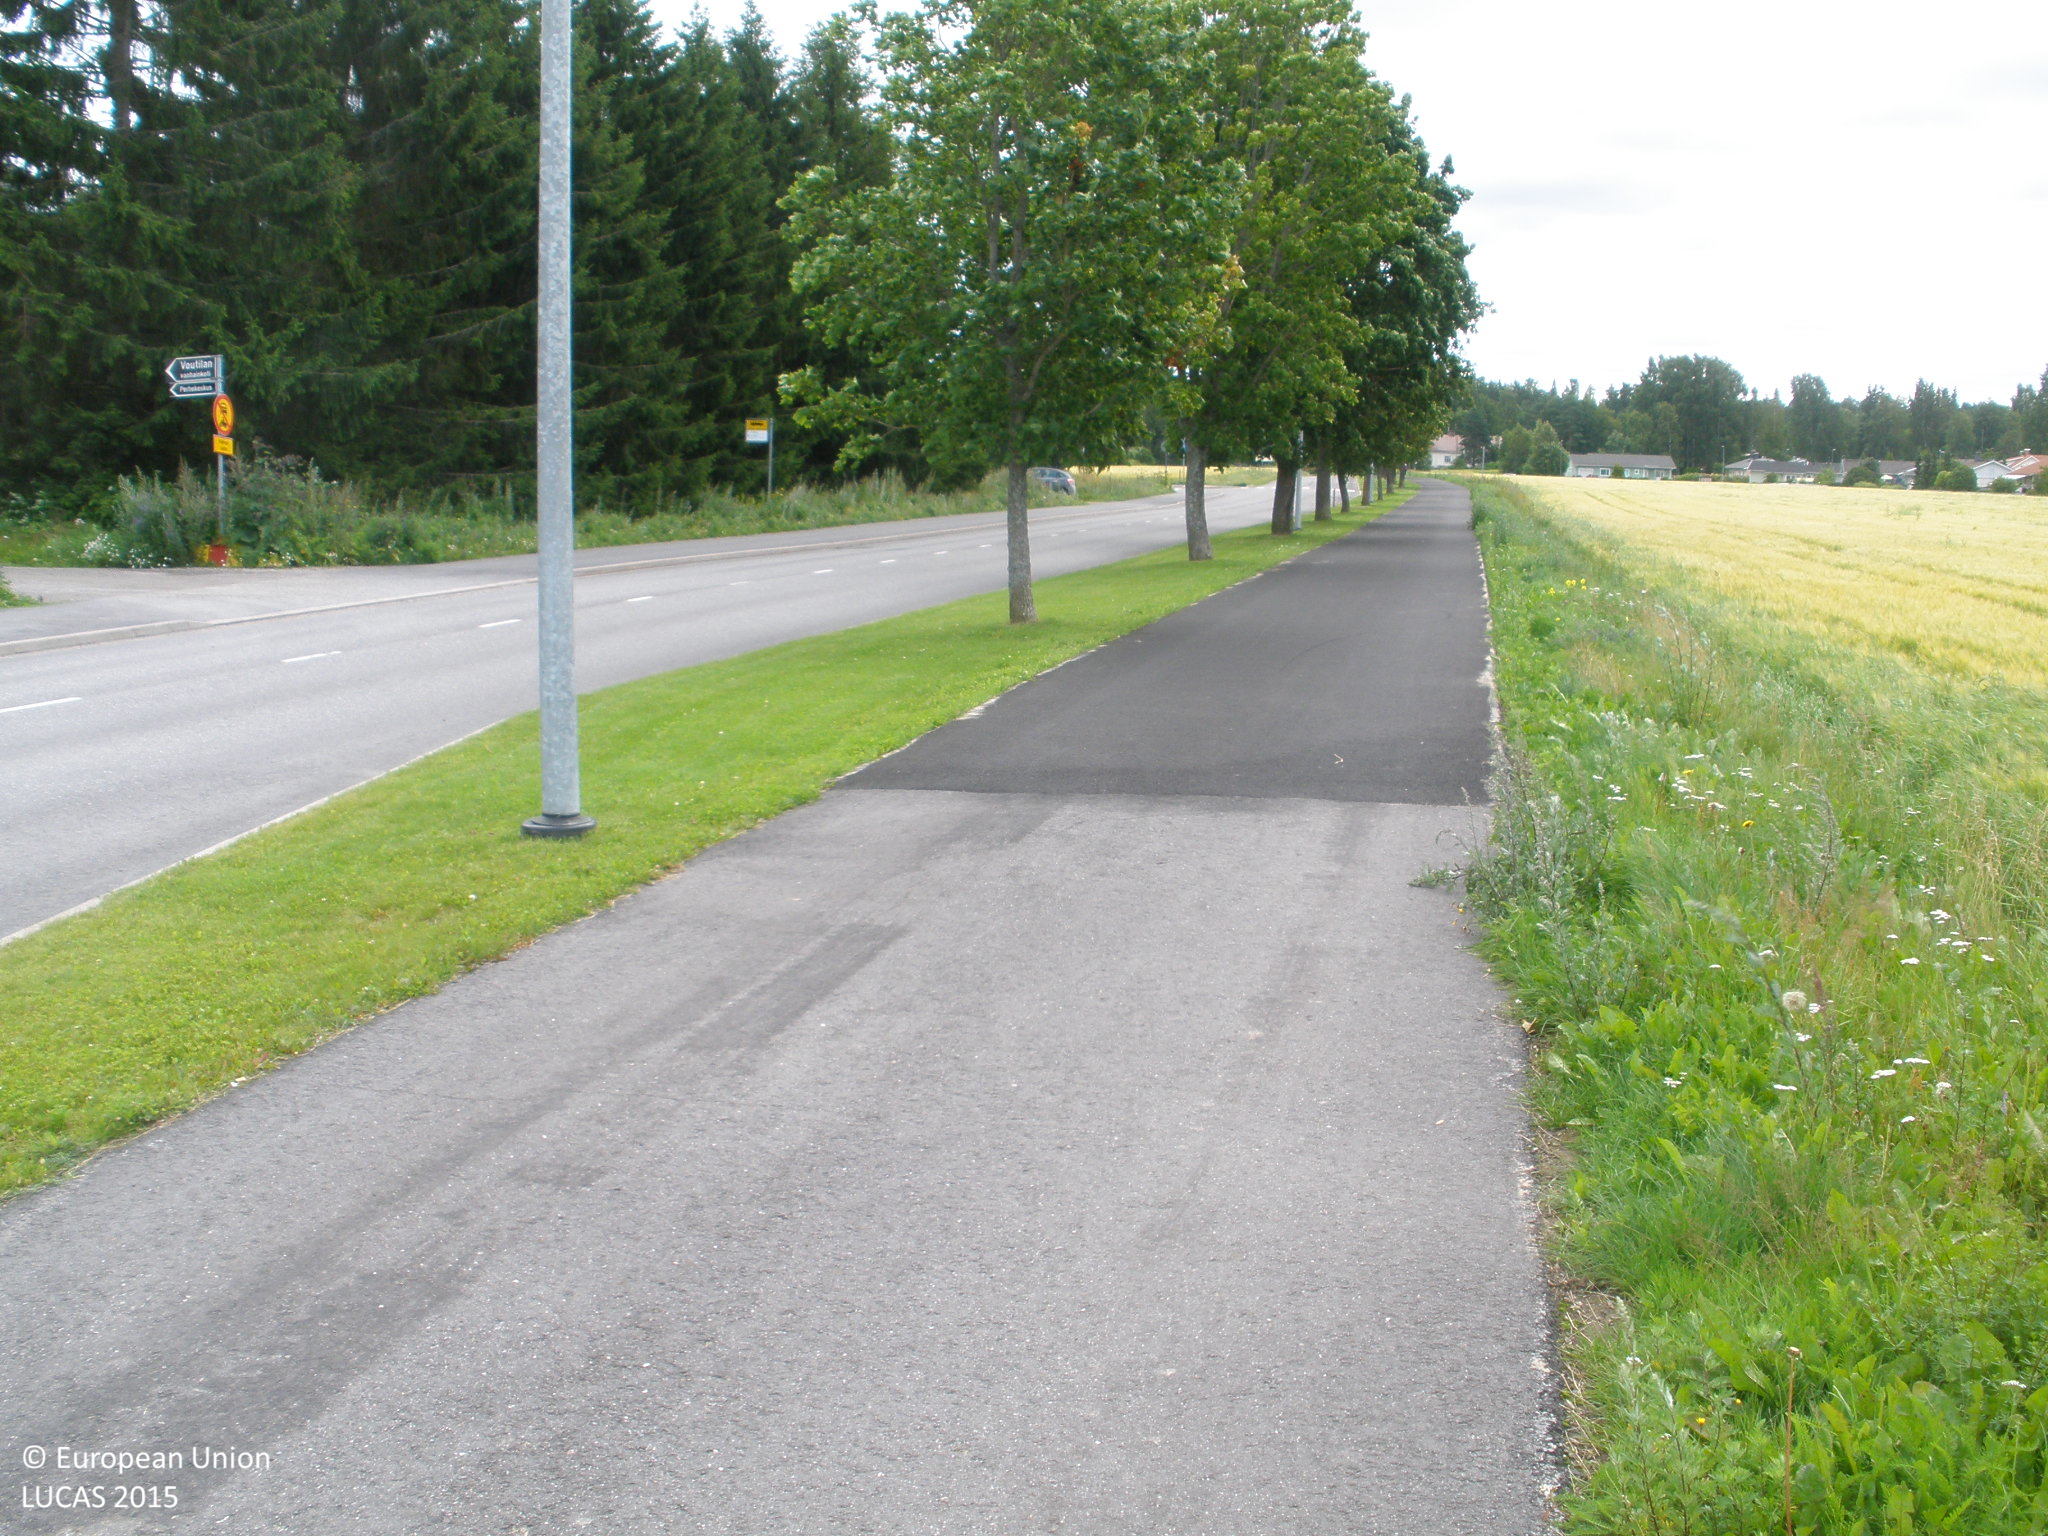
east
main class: Cropland
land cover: Oats
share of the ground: 50 - 75 %
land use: Agriculture (excluding fallow land and kitchen gardens)
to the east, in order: Oats; Barley
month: August
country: FI
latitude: 60.9758
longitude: 24.4206
